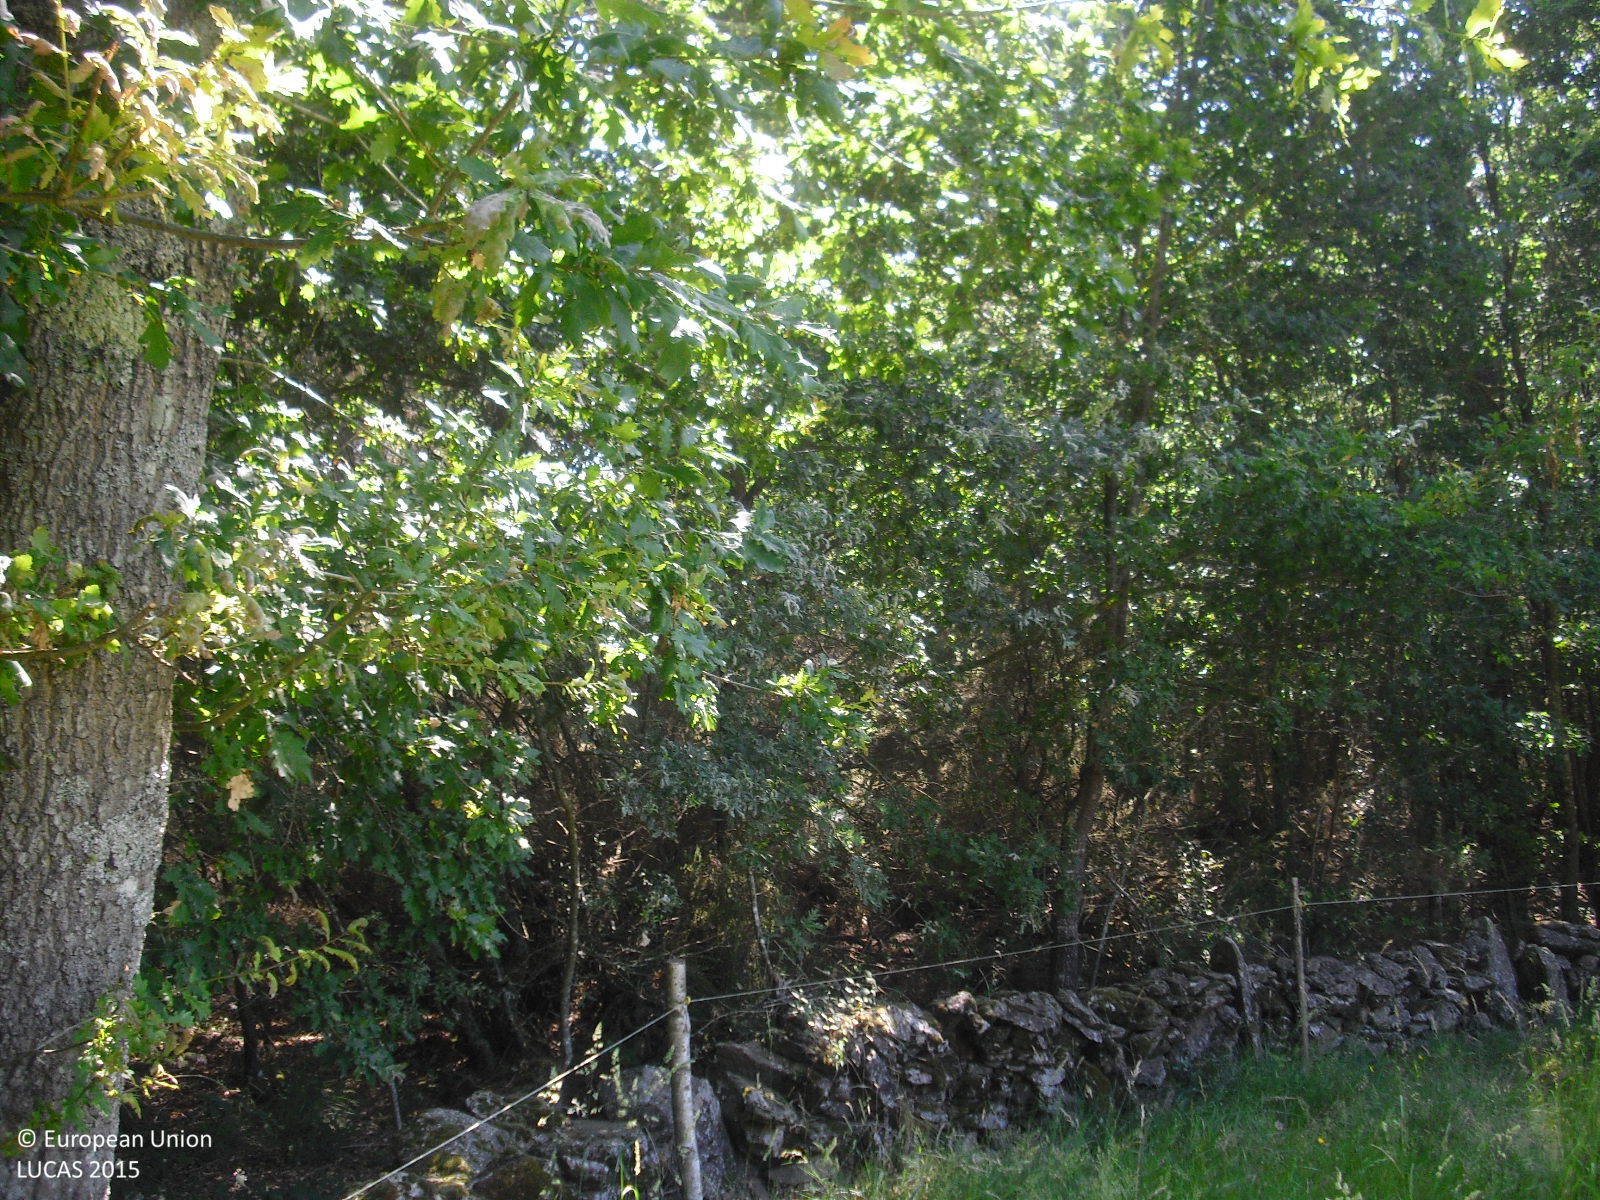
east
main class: Woodland
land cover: Broadleaved woodland
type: acidophilous oak and oak-birch forest
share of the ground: > 75 %
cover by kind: broadleaved forest trees 80 %, coniferous forest trees 20 %
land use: Forestry
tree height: > 5 m
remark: Clear cut
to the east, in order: Broadleaved woodland; Dry stone walls; Grassland without tree/shrub cover; Dry stone walls; Pine dominated mixed woodland; Broadleaved woodland; Dry stone walls; Broadleaved woodland; Dry stone walls; Pine dominated mixed woodland; Dry stone walls; Pine dominated mixed woodland; Dry stone walls; Pine dominated mixed woodland; Tracks; Pine dominated mixed woodland; Dry stone walls; Shruby margins; Grassland without tree/shrub cover; Shrubland without tree cover; Electric lines
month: June
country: ES
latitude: 42.5784
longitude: -7.7810
